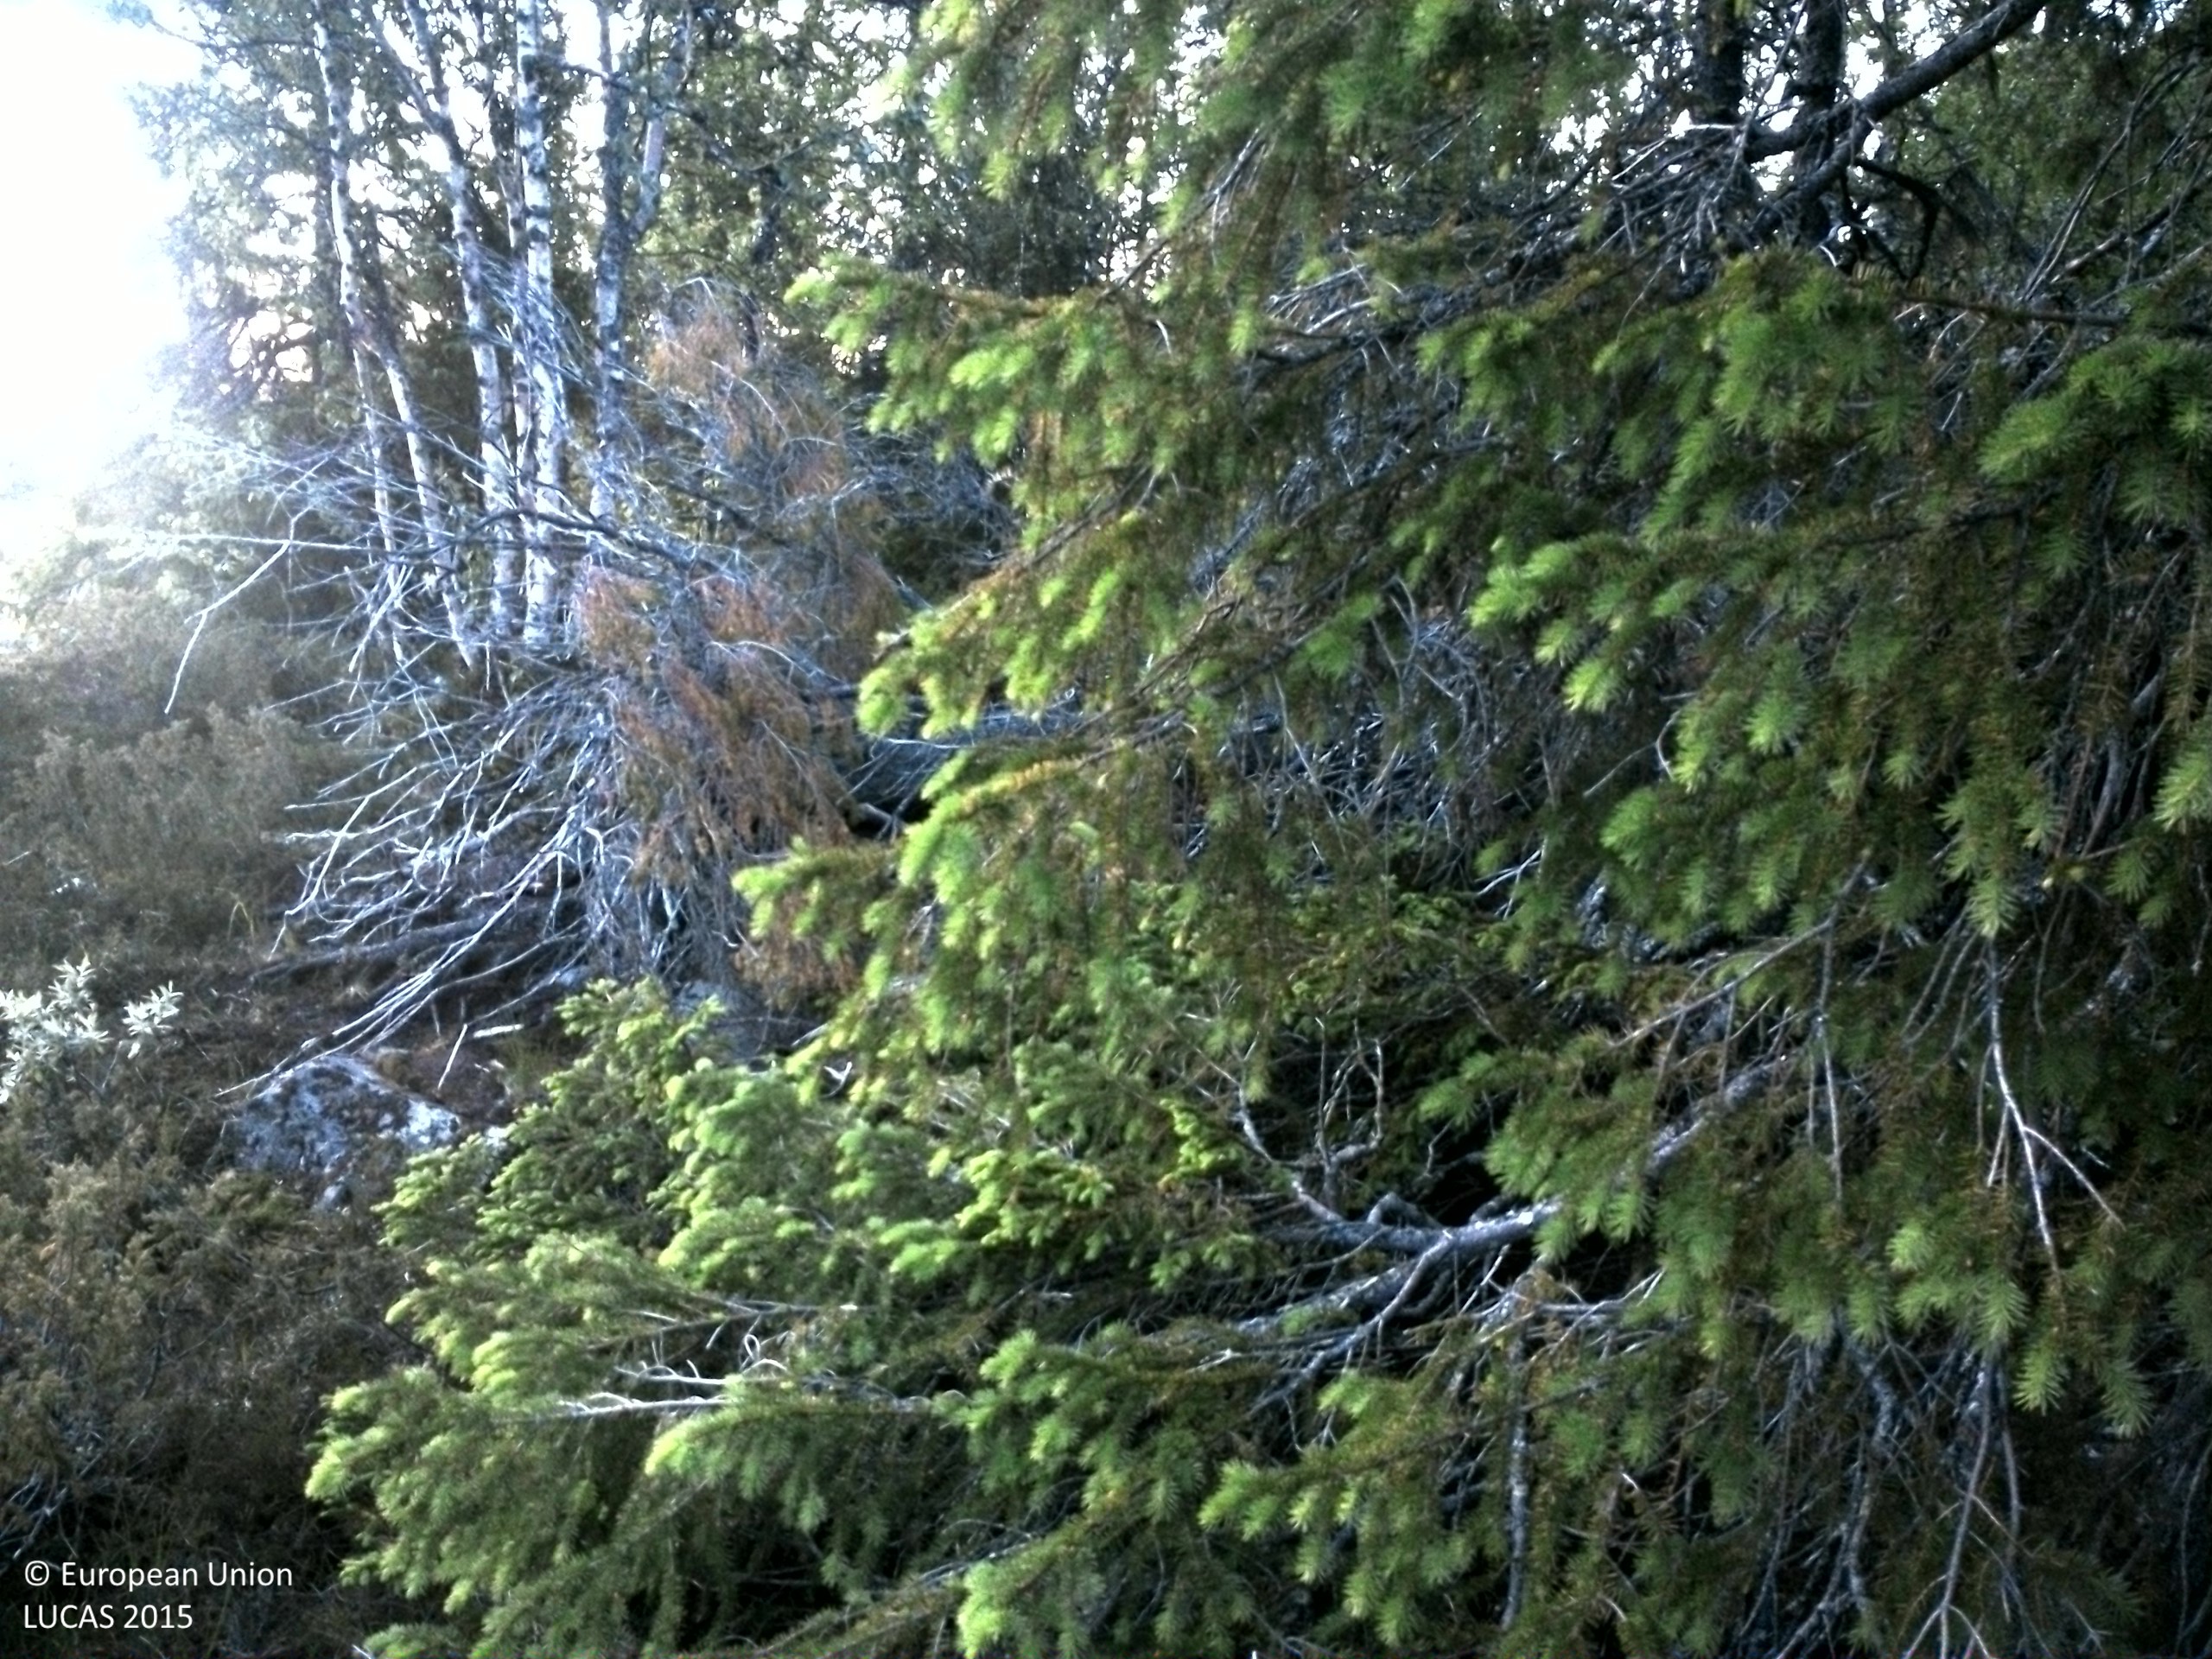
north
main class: Woodland
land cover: Spruce dominated mixed woodland
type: boreal forest
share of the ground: 50 - 75 %
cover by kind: coniferous forest trees 35 %, shrubs 35 %, broadleaved forest trees 15 %, herbaceous plants 10 %, consolidated bare surface 5 %
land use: Forestry
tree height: > 5 m
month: July
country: SE
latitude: 64.7792
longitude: 15.3327
